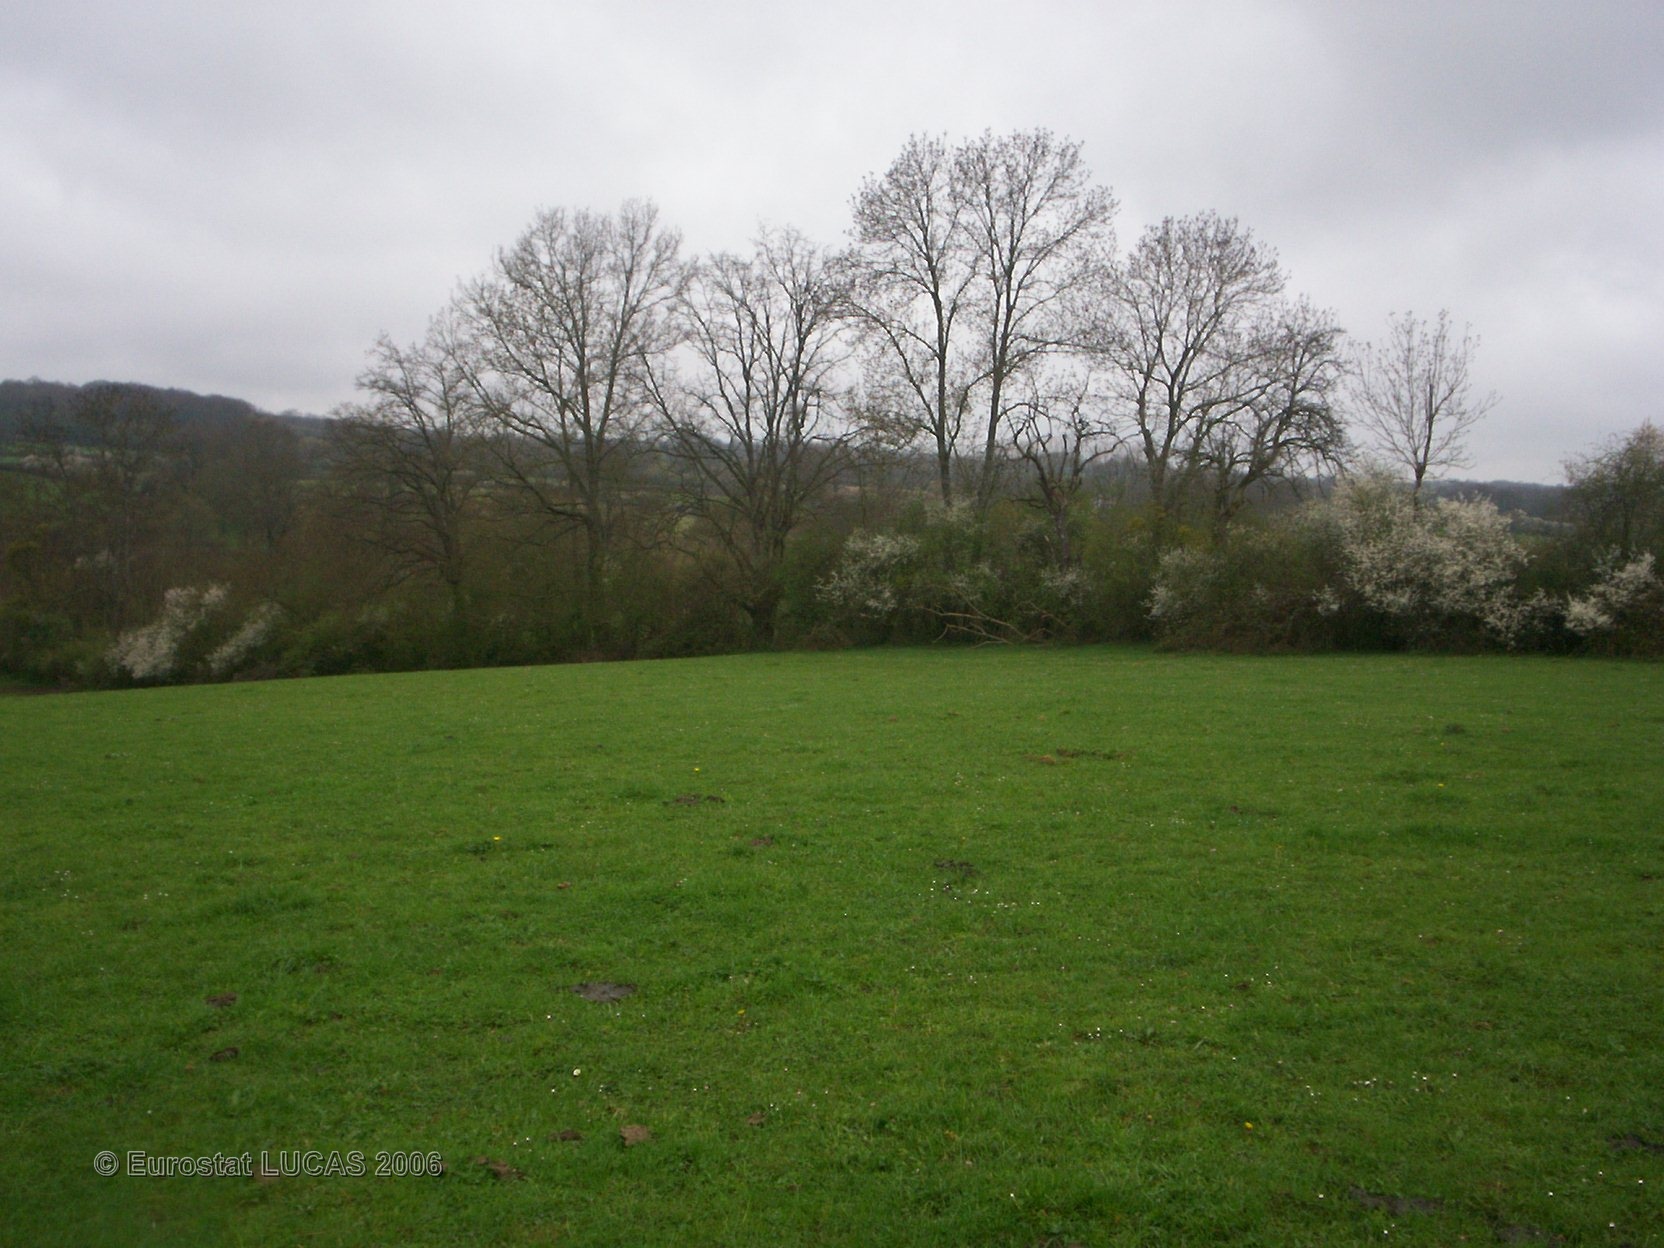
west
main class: Grassland
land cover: Grassland without tree/shrub cover
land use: Agriculture (excluding fallow land and kitchen gardens)
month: April
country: FR
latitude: 47.5309
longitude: 2.9940
